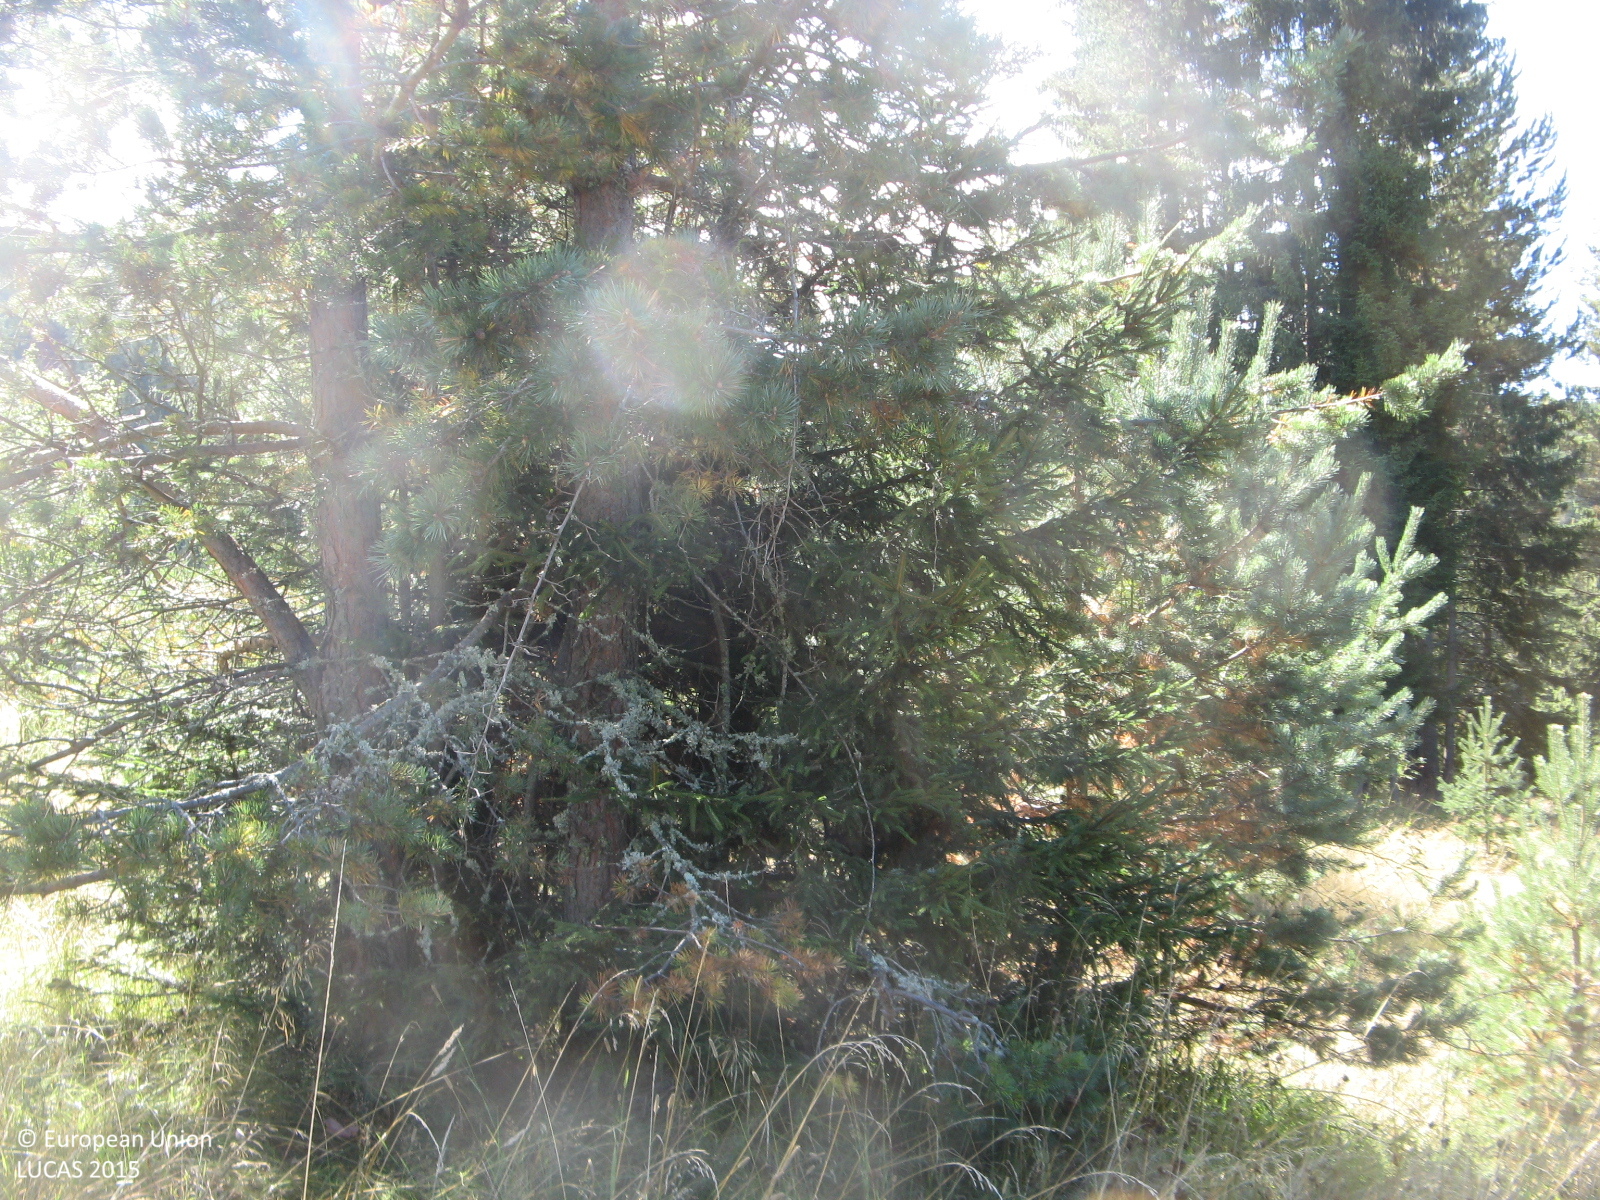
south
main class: Grassland
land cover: Grassland with sparse tree/shrub cover
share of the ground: > 75 %
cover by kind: herbaceous plants 90 %, coniferous forest trees 5 %, shrubs 5 %
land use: Fallow land
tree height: < 5 m
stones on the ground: < 10 %
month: September
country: BG
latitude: 41.5971
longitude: 24.4242
